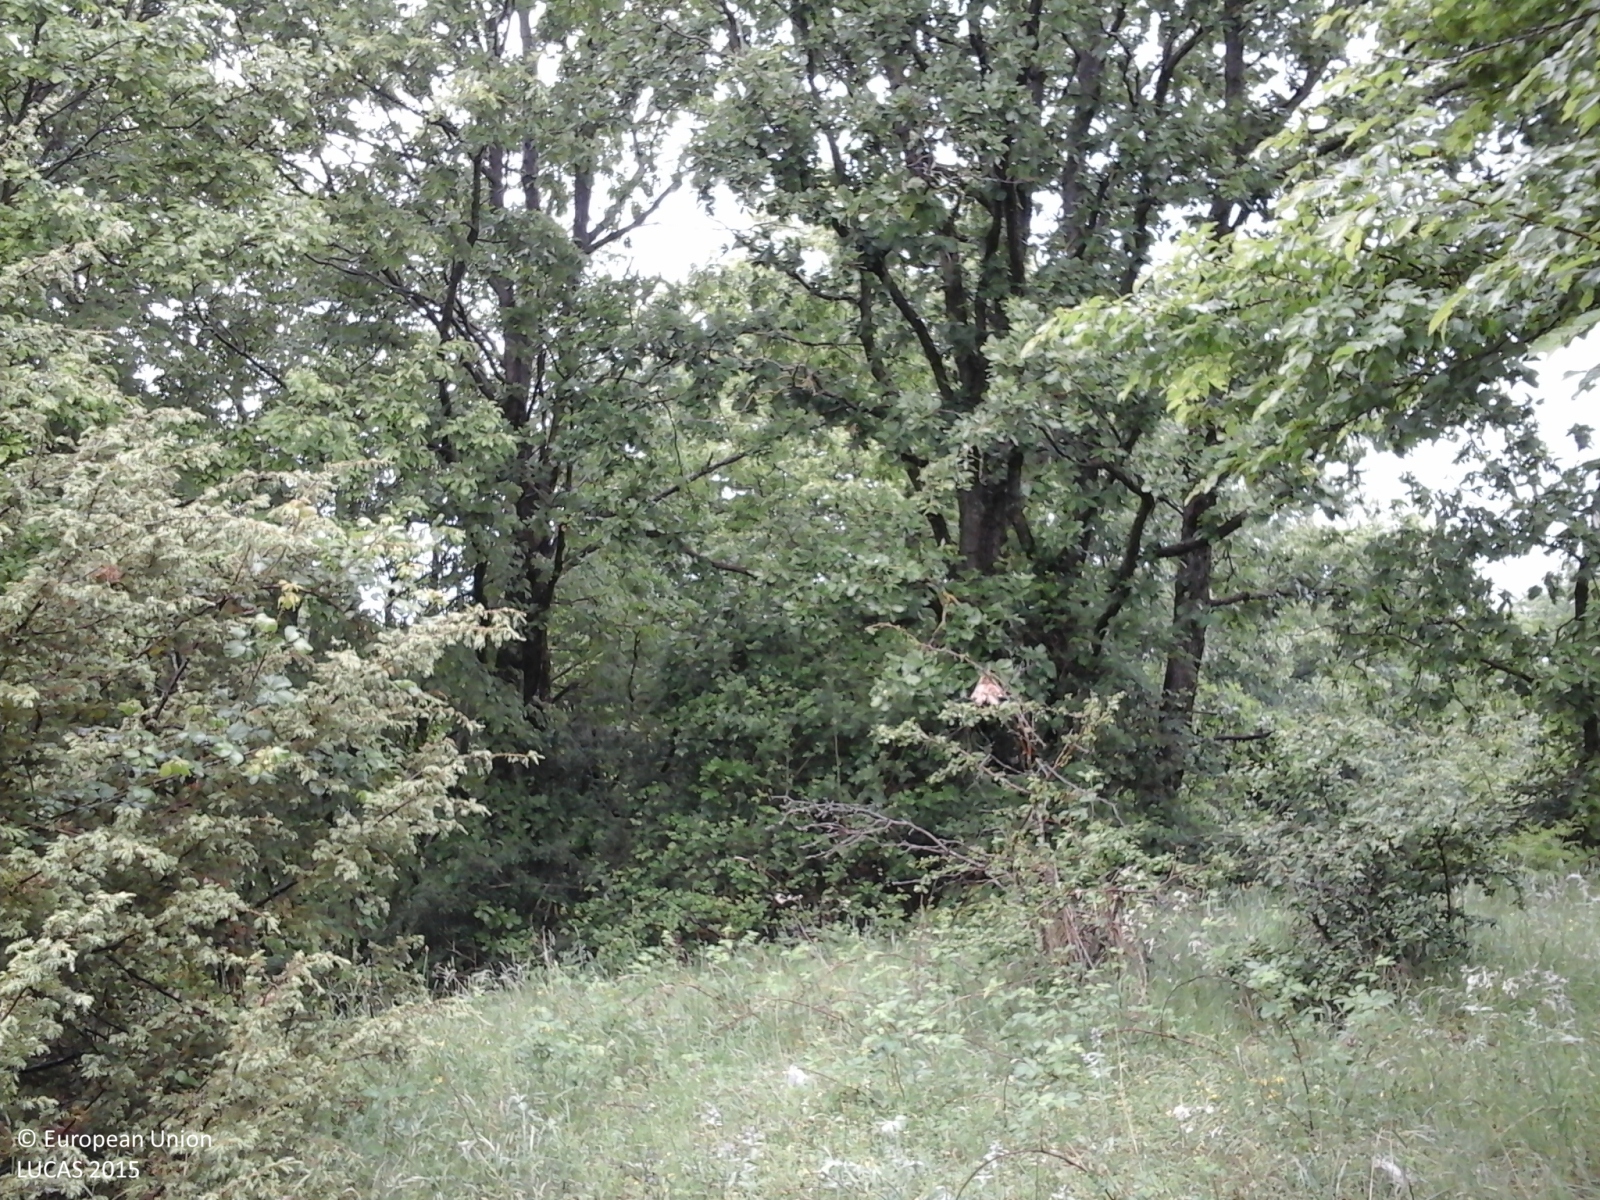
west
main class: Woodland
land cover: Broadleaved woodland
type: thermophilous deciduous forest
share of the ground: 50 - 75 %
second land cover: Grassland without tree/shrub cover
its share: 50 - 75 %
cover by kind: broadleaved forest trees 90 %, shrubs 5 %, herbaceous plants 5 %
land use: Forestry
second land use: Agriculture (excluding fallow land and kitchen gardens)
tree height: > 5 m
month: May
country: IT
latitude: 41.8267
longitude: 13.1790
